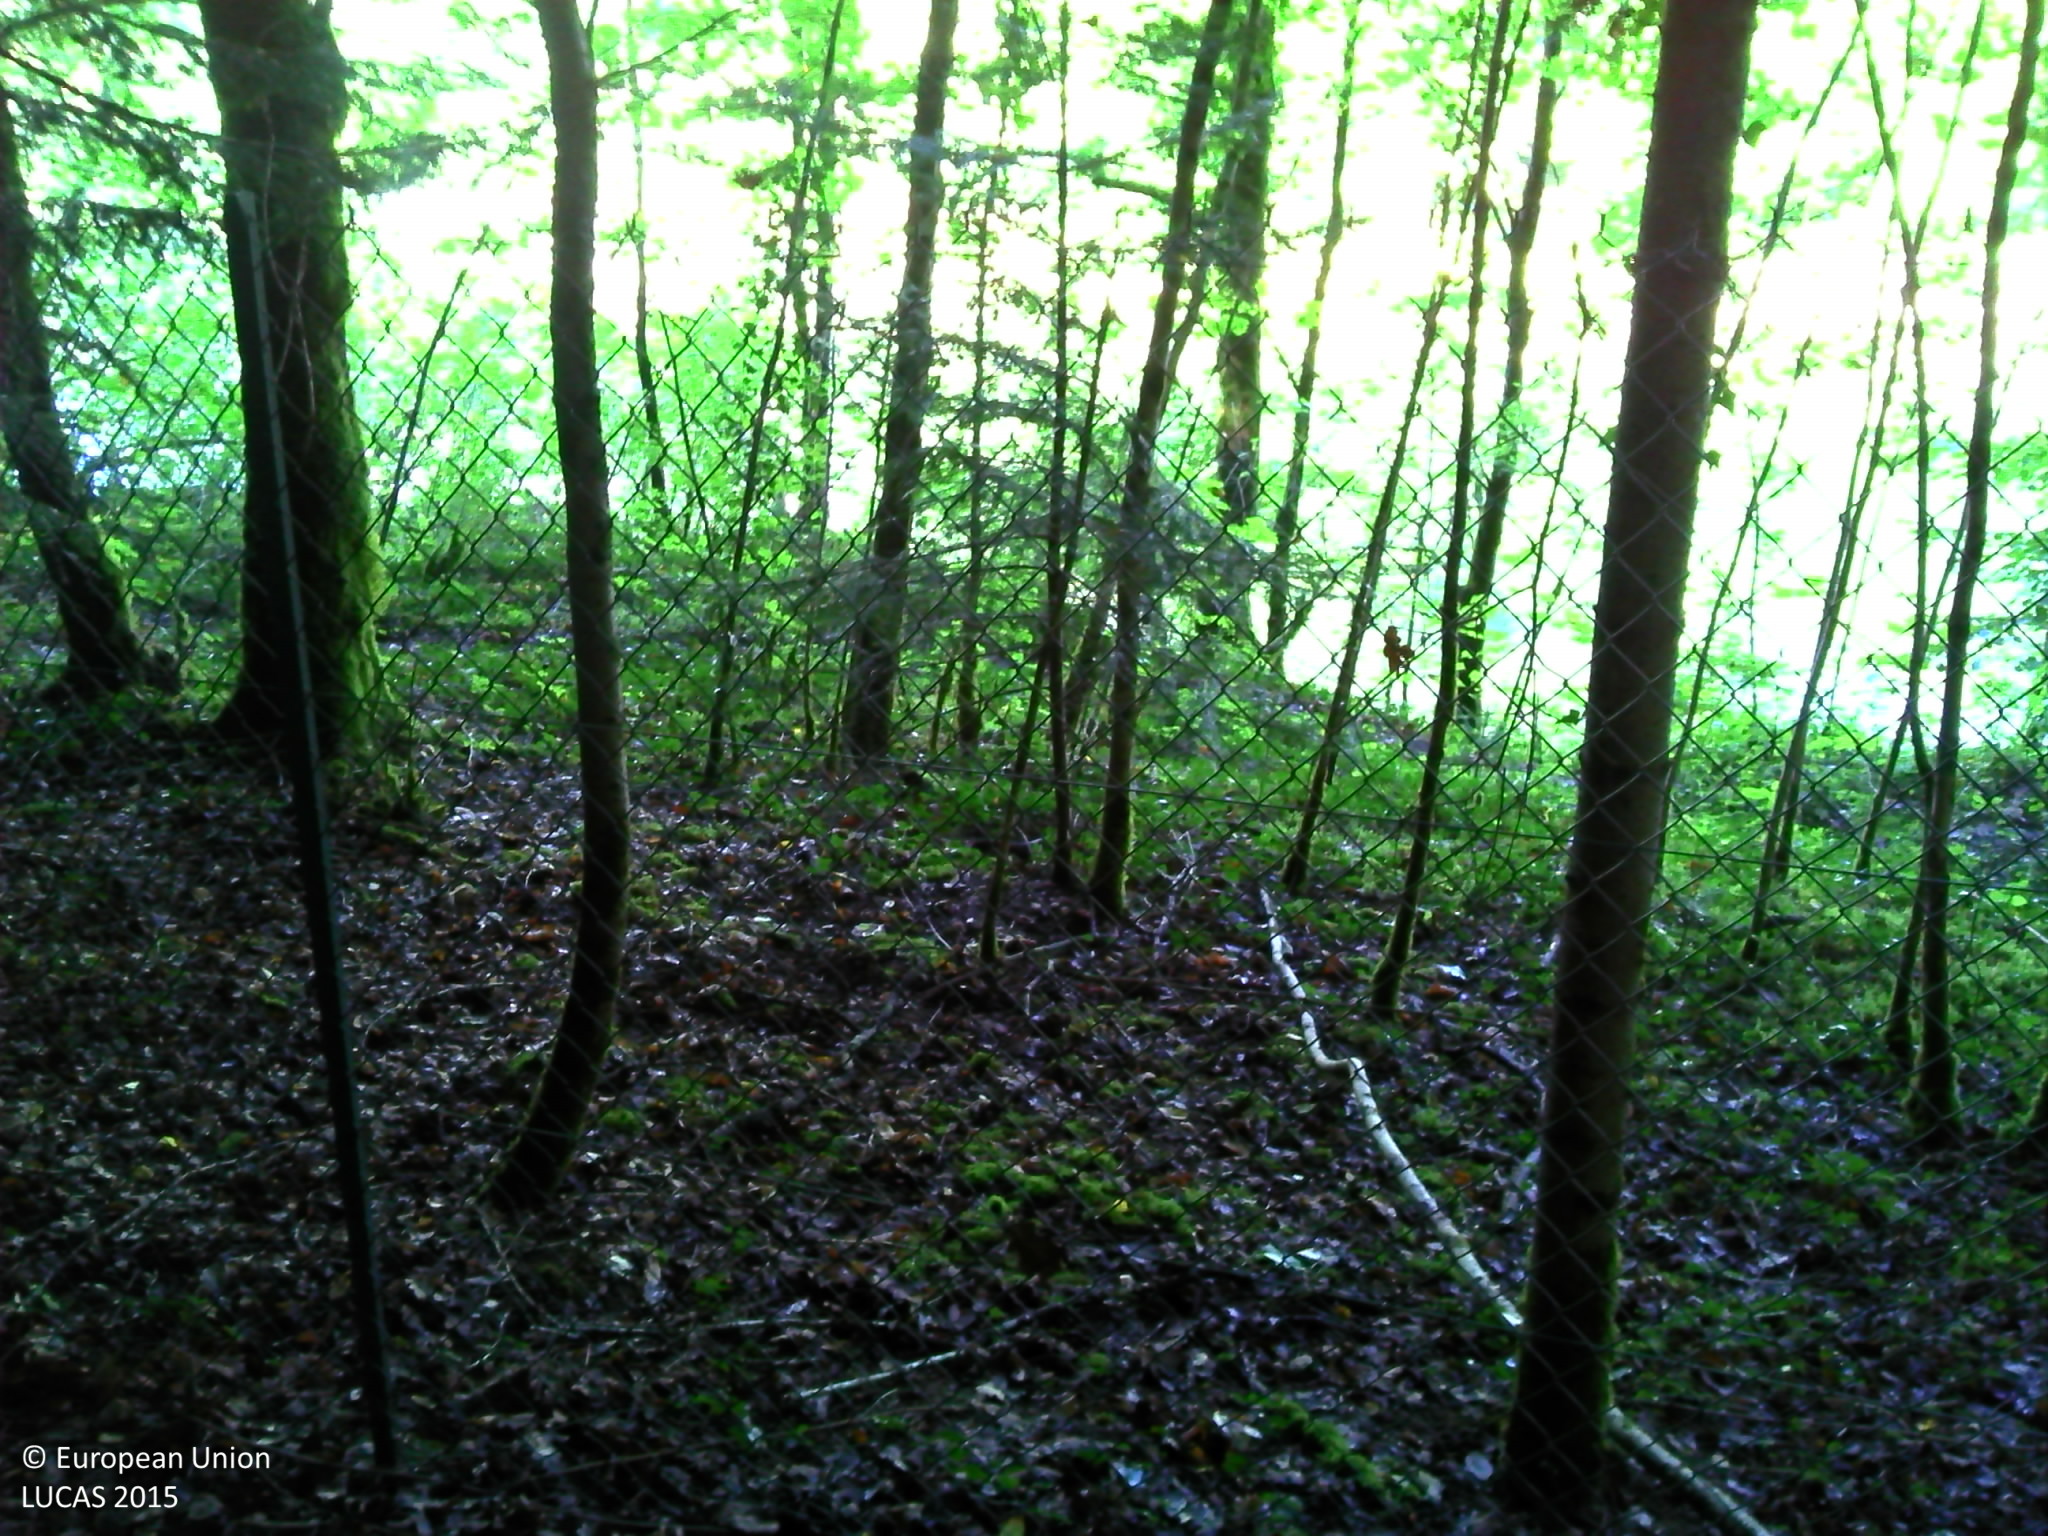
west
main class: Woodland
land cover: Broadleaved woodland
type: floodplain forest
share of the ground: > 75 %
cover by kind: broadleaved forest trees 90 %, herbaceous plants 5 %, unconsolidated bare surface 5 %
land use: Forestry
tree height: > 5 m
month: September
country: FR
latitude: 47.1099
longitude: 6.1144
